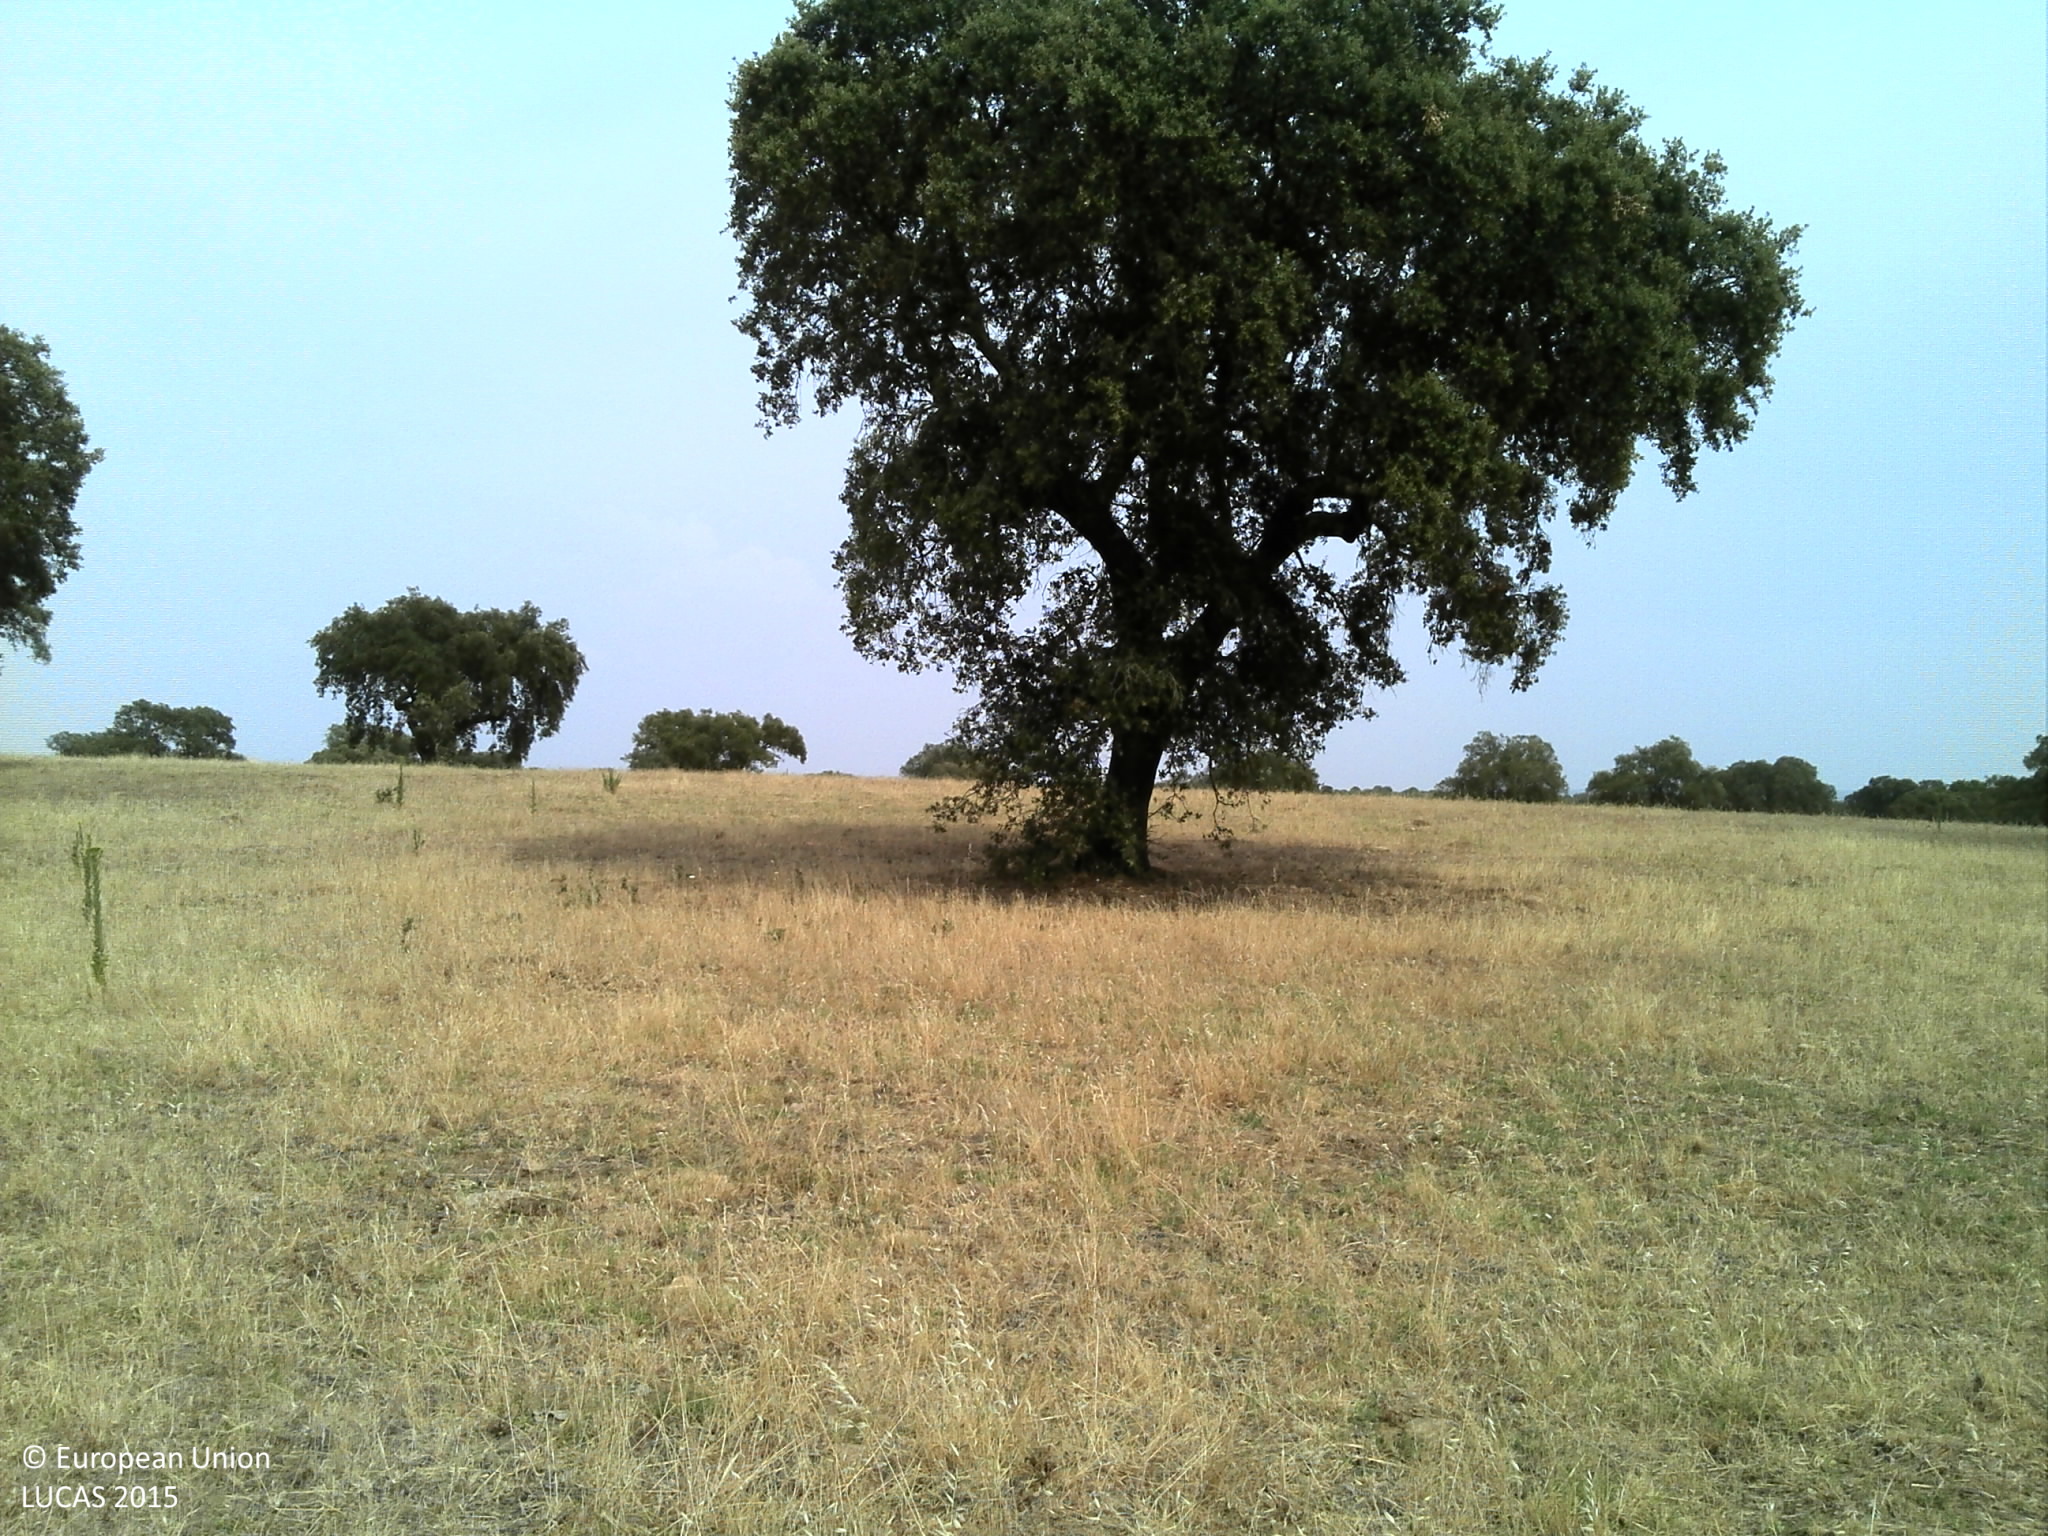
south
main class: Grassland
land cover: Grassland without tree/shrub cover
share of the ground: 25 - 50 %
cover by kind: unconsolidated bare surface 65 %, herbaceous plants 35 %
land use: Agriculture (excluding fallow land and kitchen gardens)
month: June
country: PT
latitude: 38.4216
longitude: -7.7991
